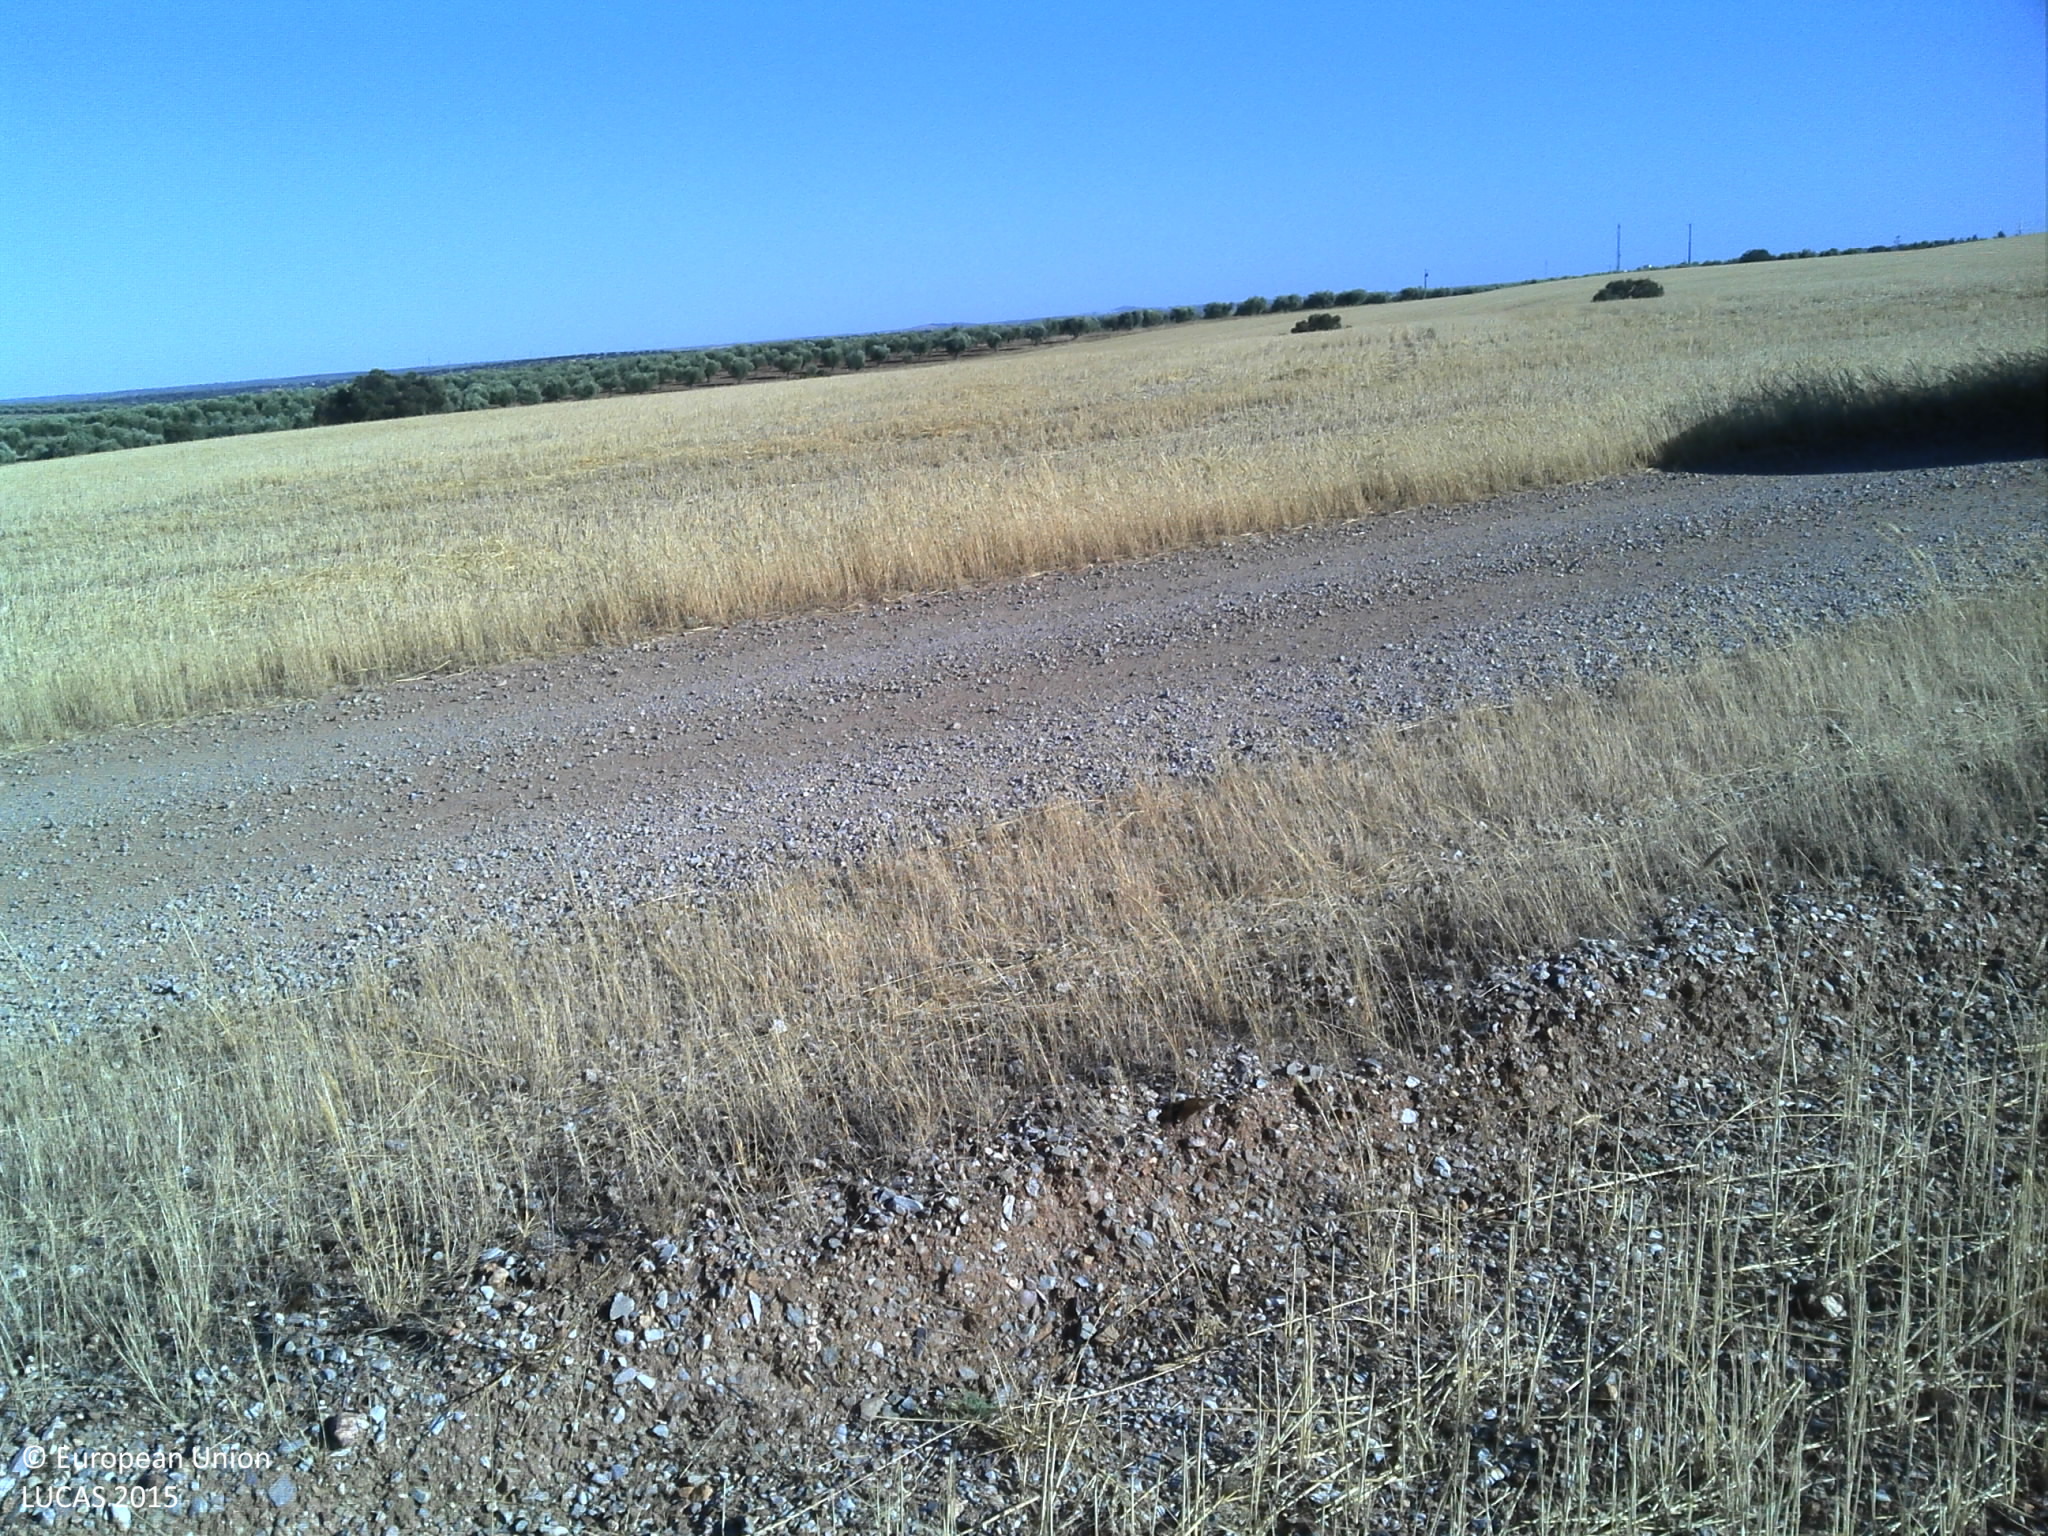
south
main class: Cropland
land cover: Common wheat
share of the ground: 25 - 50 %
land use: Agriculture (excluding fallow land and kitchen gardens)
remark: Harvested field
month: July
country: PT
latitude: 38.1351
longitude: -7.6520
